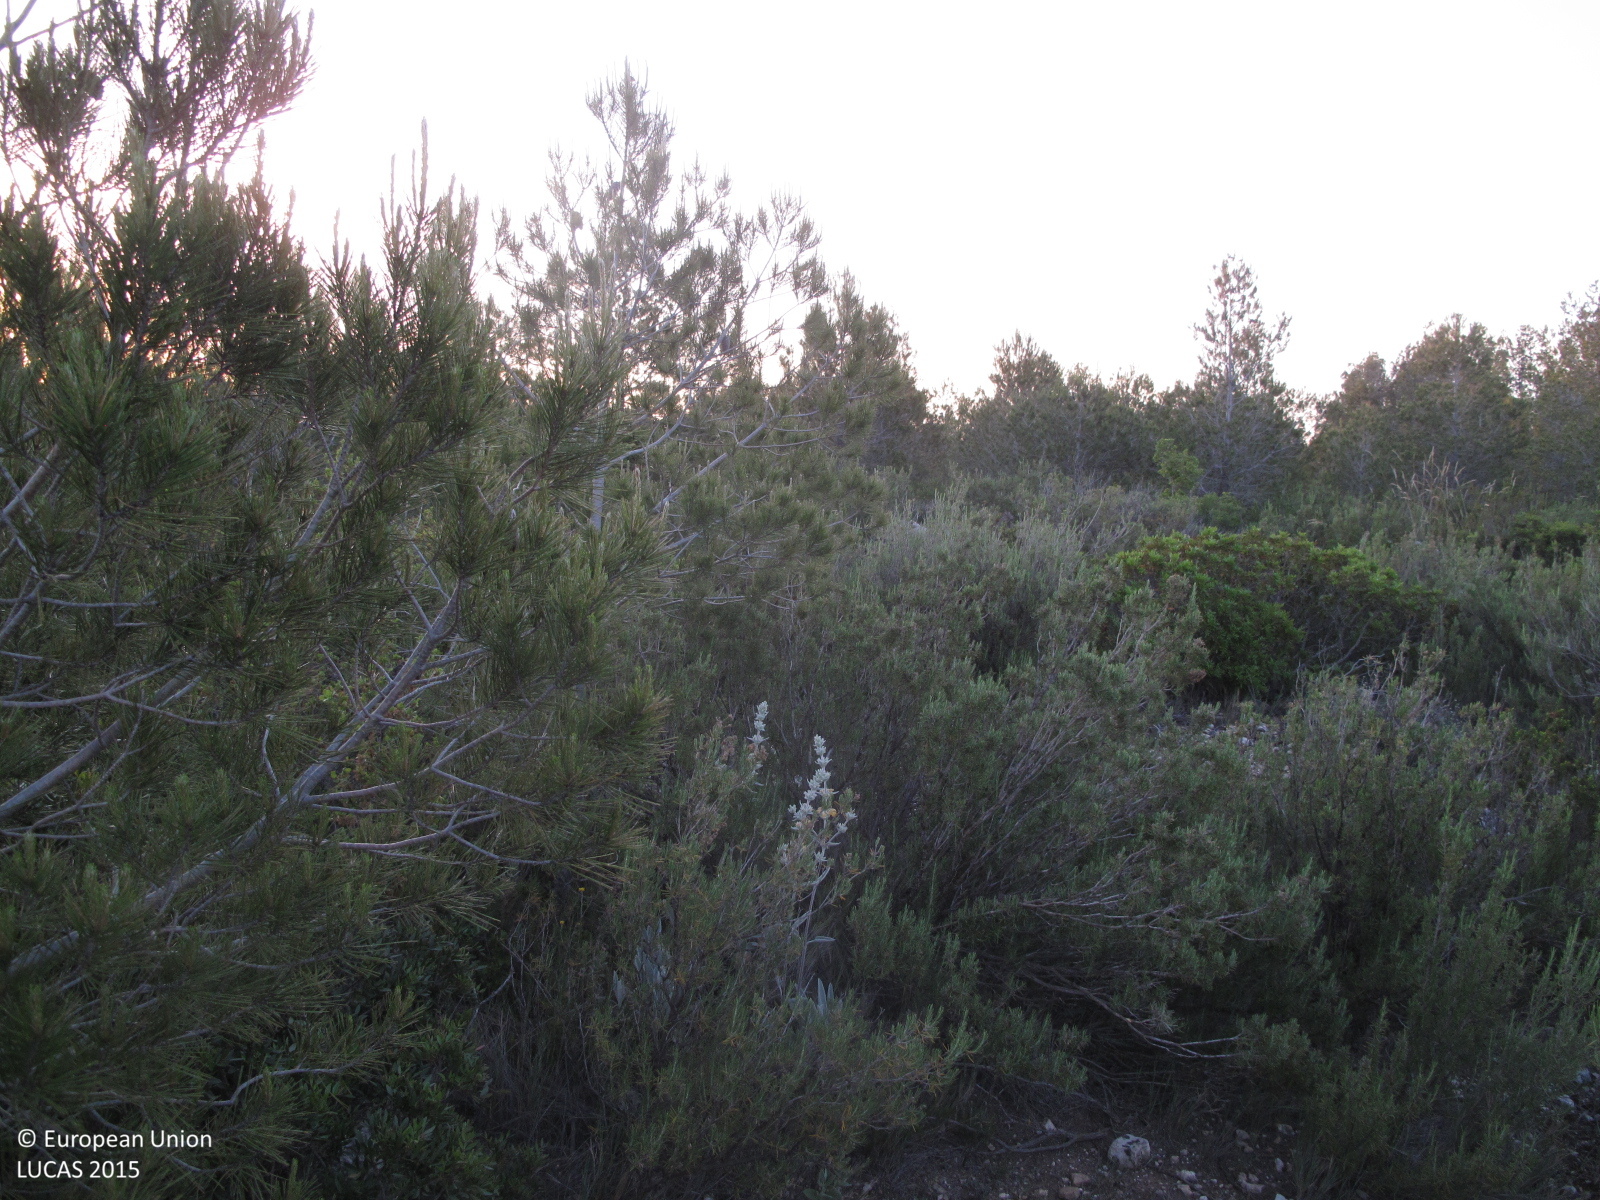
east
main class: Woodland
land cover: Pine dominated coniferous woodland
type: coniferous forest of the mediterranean region
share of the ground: 25 - 50 %
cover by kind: coniferous forest trees 40 %, shrubs 20 %, herbaceous plants 20 %, consolidated bare surface 20 %
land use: Semi-natural and natural areas not in use
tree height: < 5 m
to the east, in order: Pine dominated coniferous woodland; Shrubland with sparse tree cover; Tracks; Shrubland with sparse tree cover; Pine dominated coniferous woodland
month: May
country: ES
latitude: 39.0491
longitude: -0.7983
